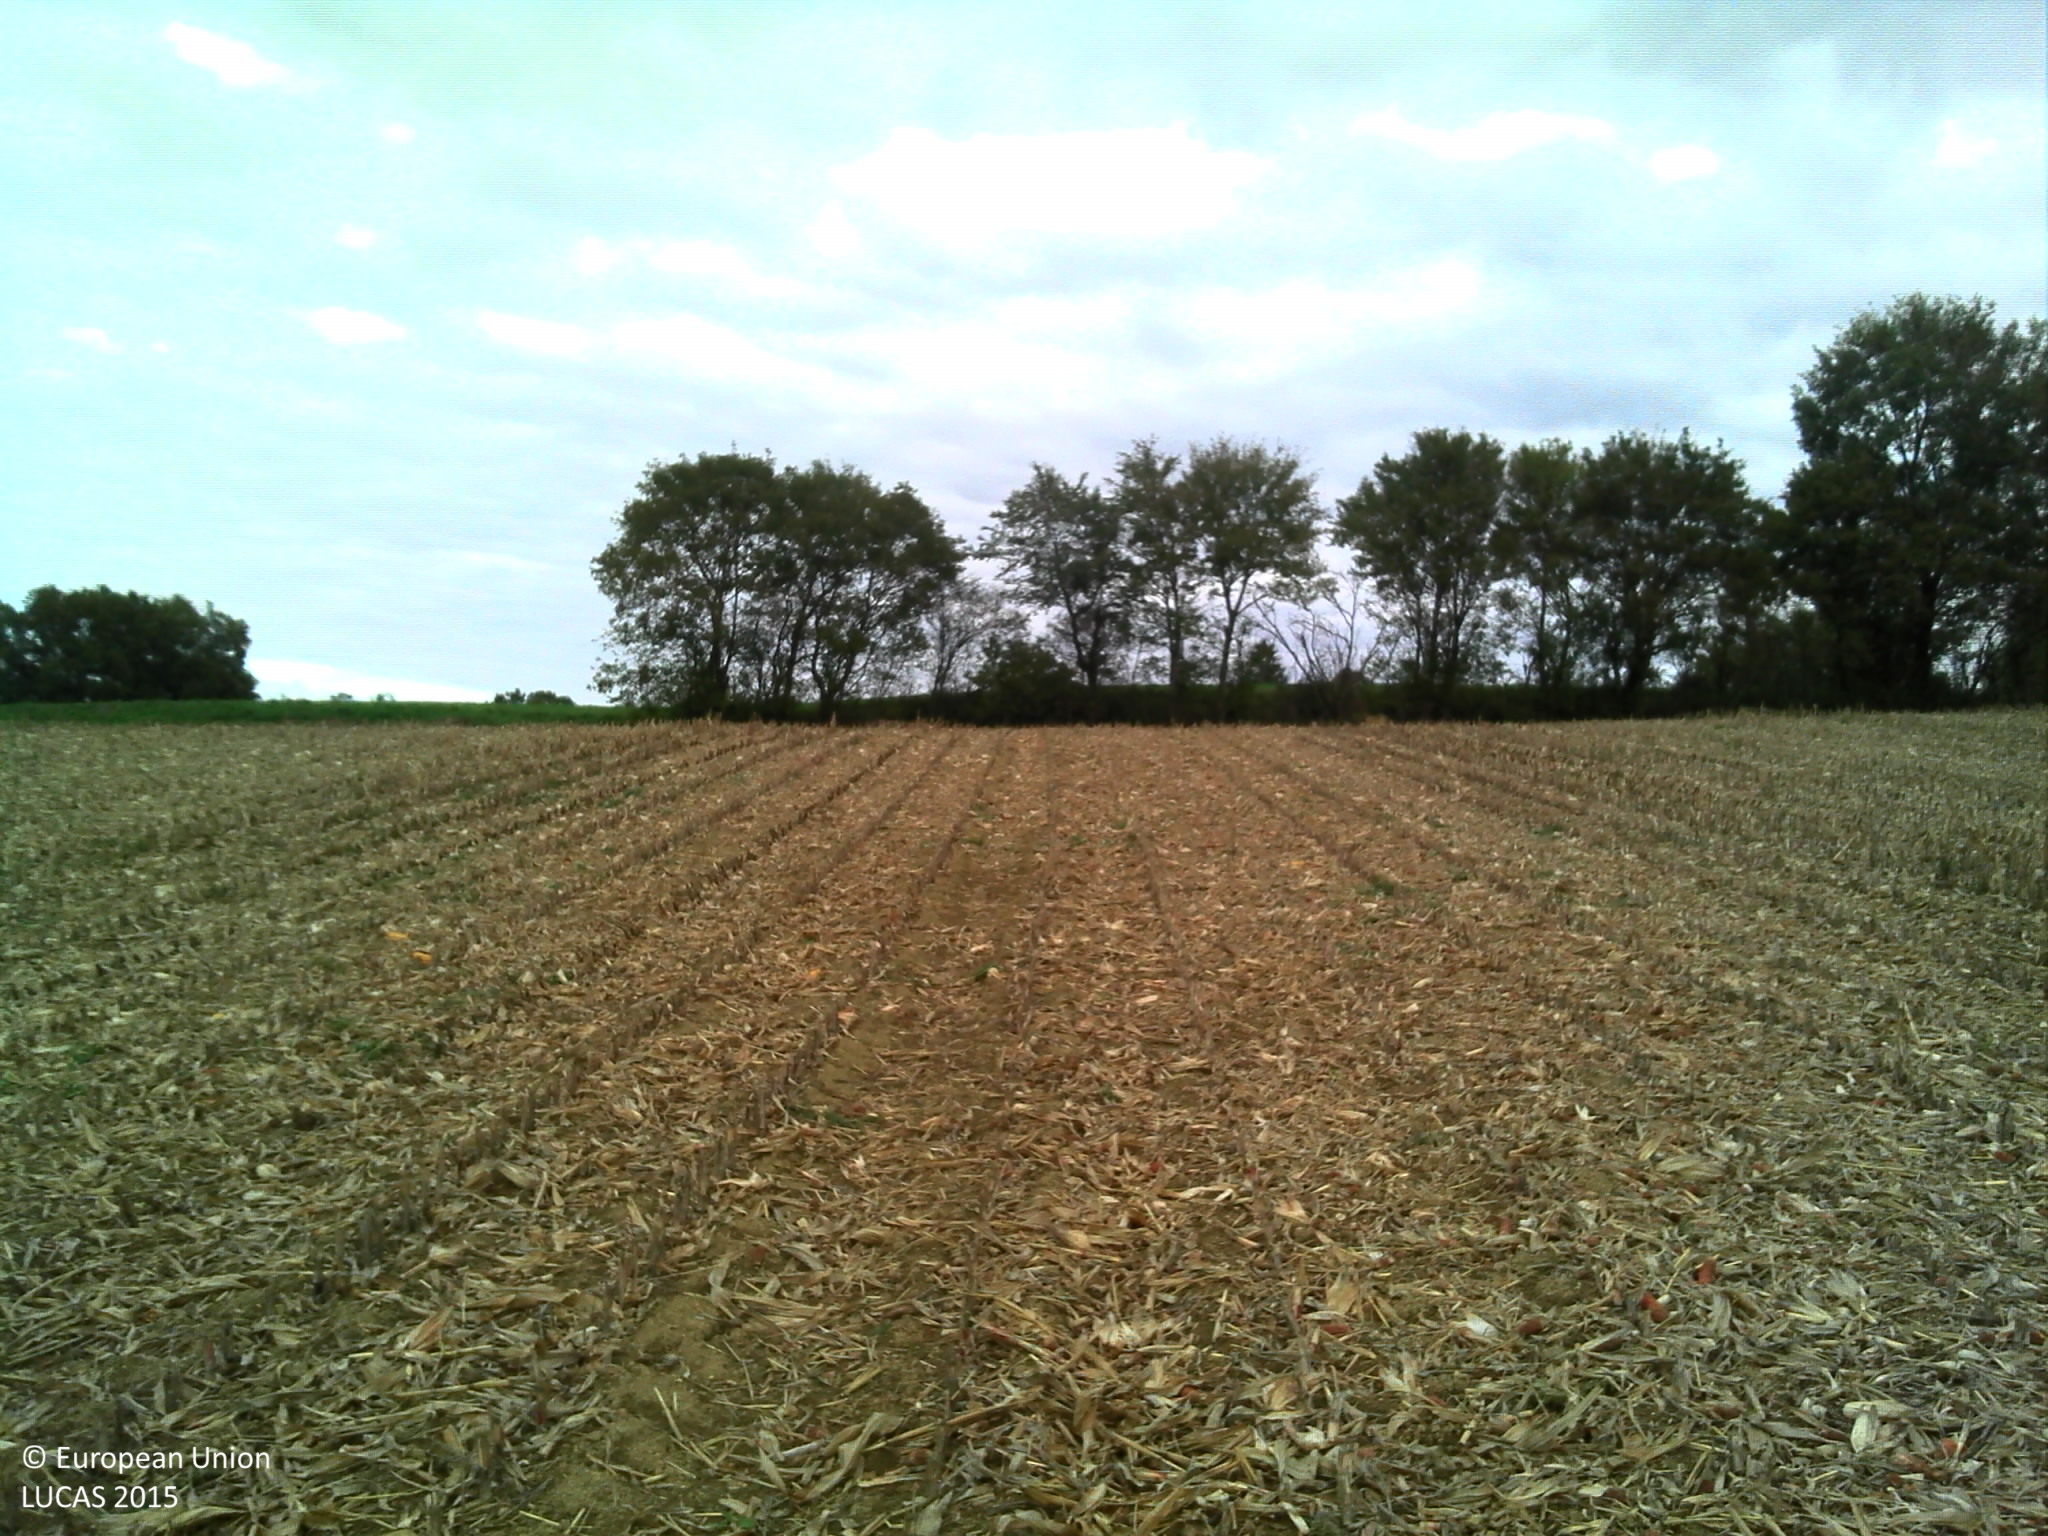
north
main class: Cropland
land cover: Maize
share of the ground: < 10 %
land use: Agriculture (excluding fallow land and kitchen gardens)
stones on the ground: < 10 %
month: October
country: FR
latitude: 46.3606
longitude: 4.9985
